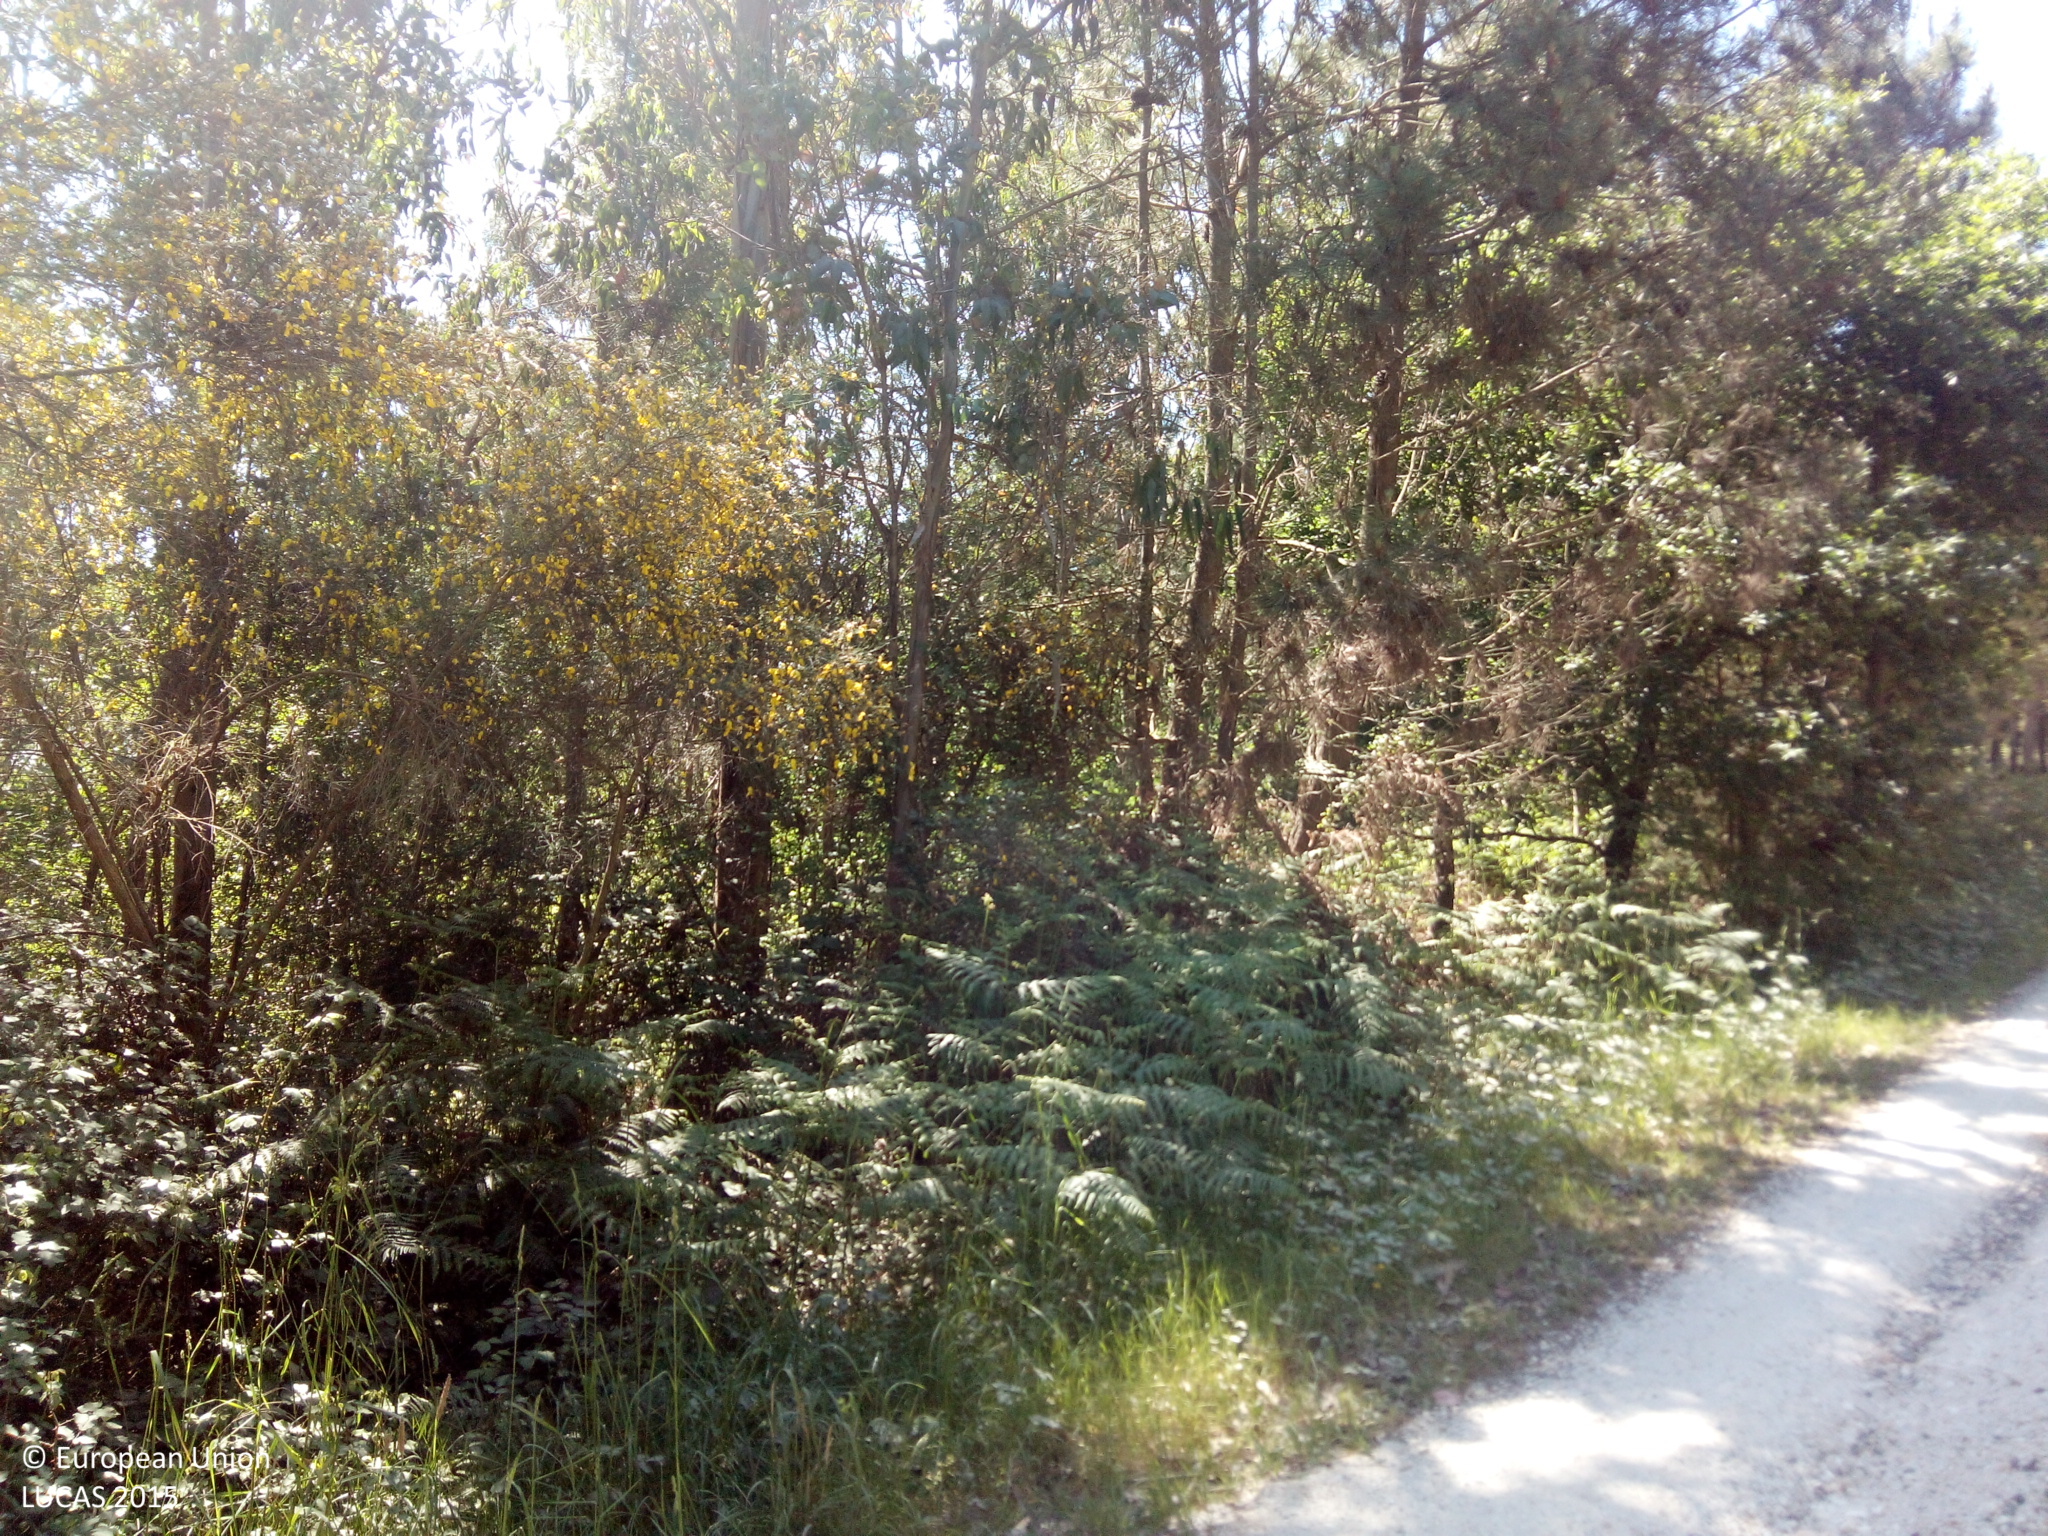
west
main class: Woodland
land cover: Pine dominated mixed woodland
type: hemiboreal forest and nemoral coniferous forest and mixed broadleaved-coniferous forest
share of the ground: > 75 %
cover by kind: coniferous forest trees 75 %, broadleaved forest trees 25 %
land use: Forestry
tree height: > 5 m
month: May
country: ES
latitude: 42.7935
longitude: -8.4265
